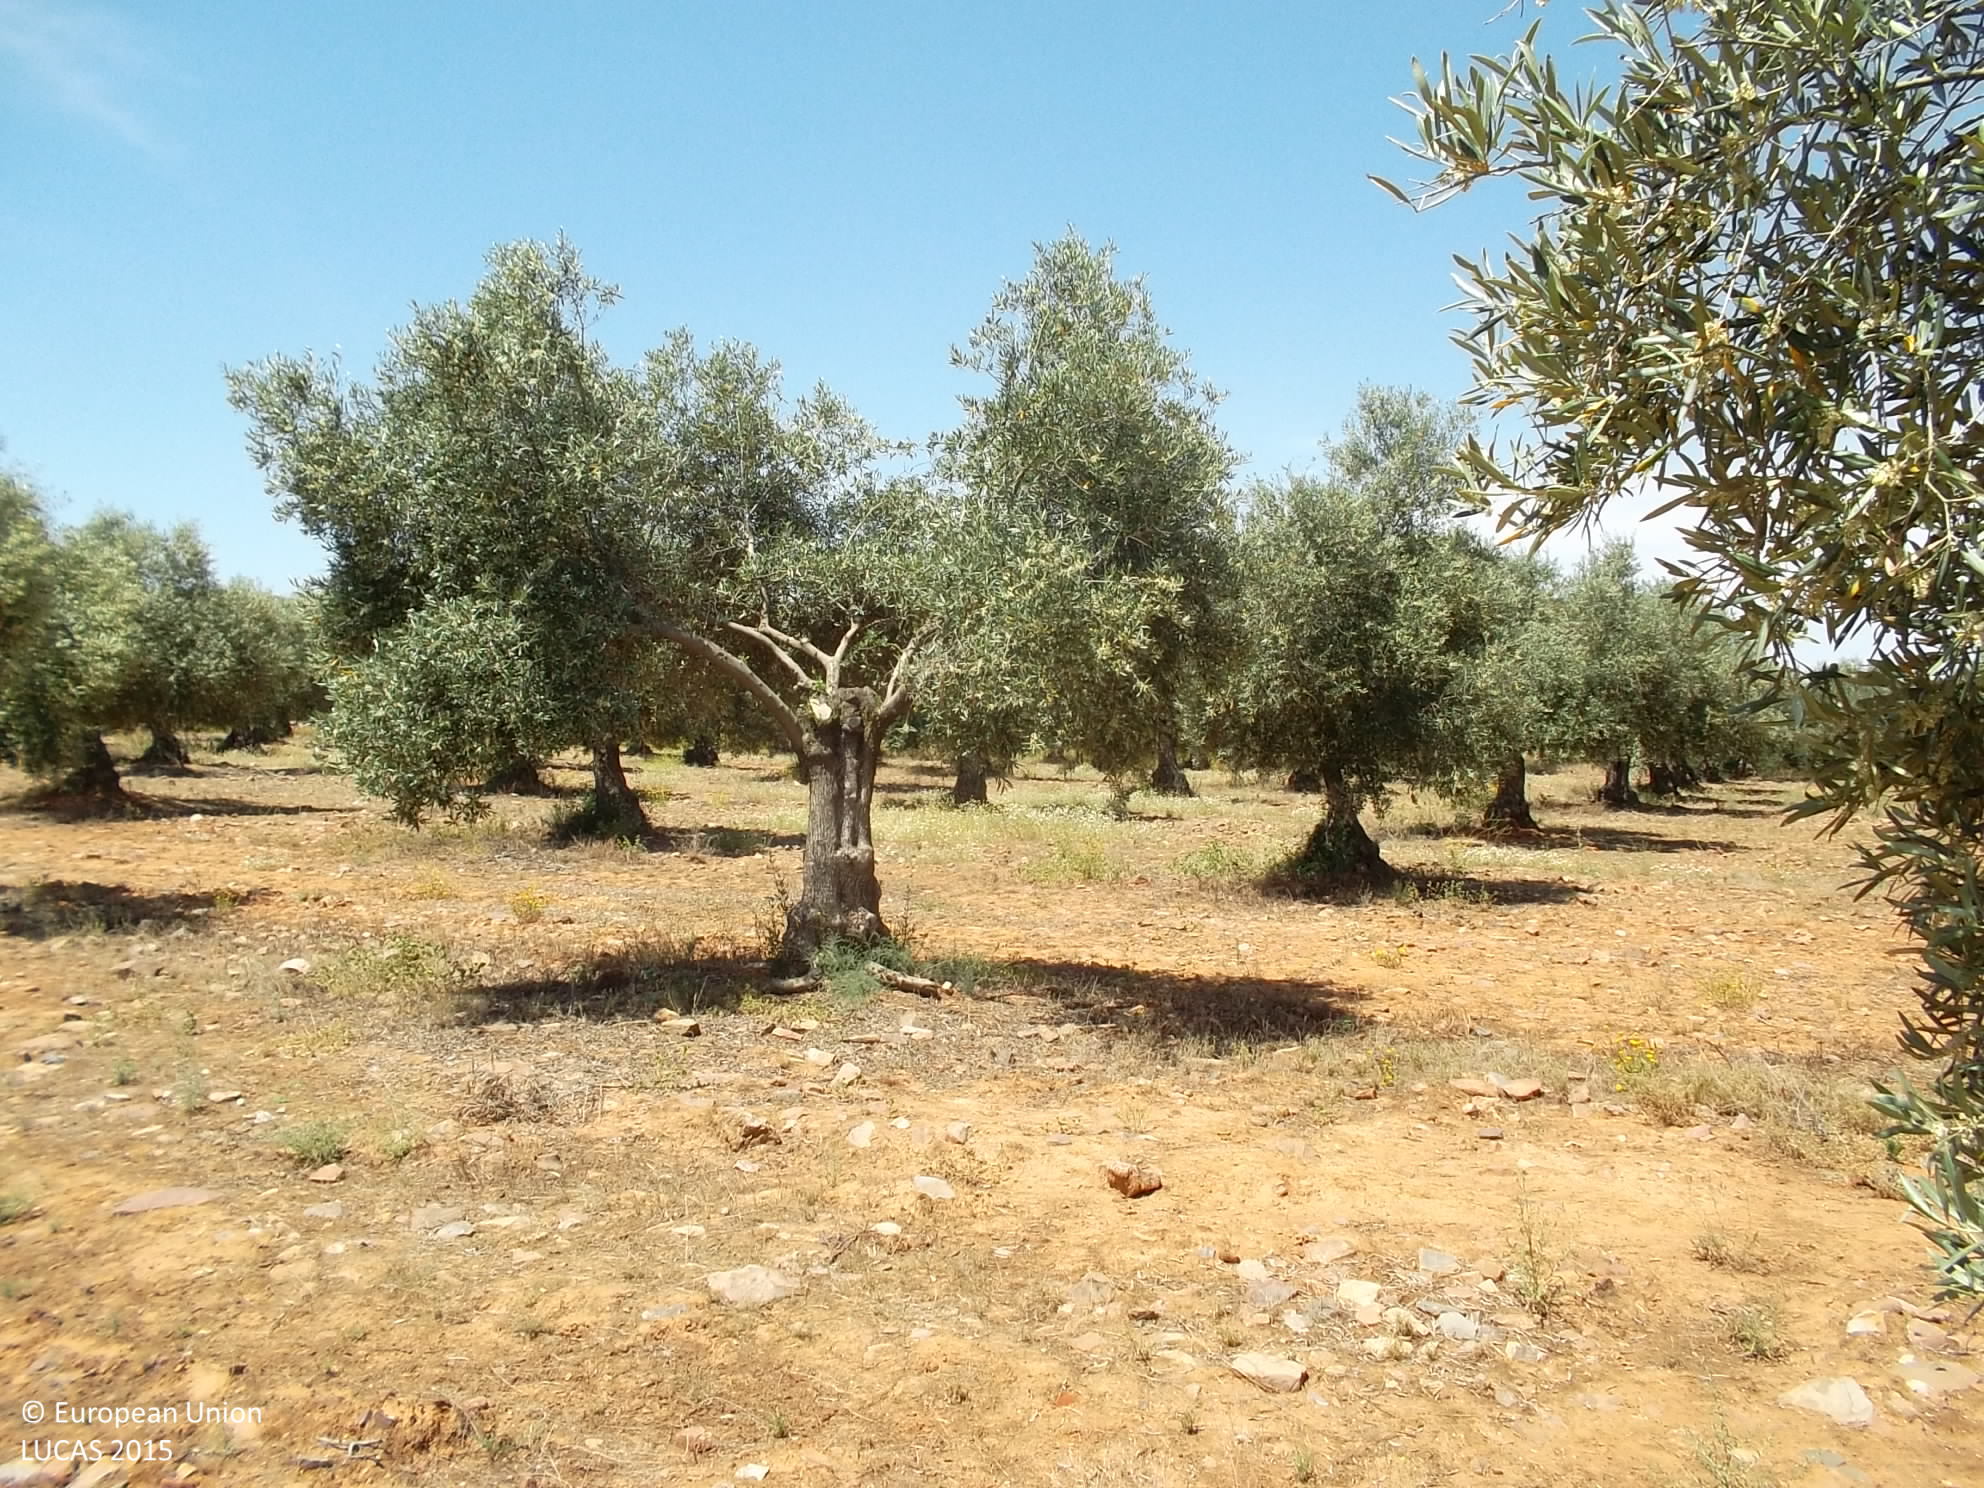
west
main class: Cropland
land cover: Olive groves
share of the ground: 25 - 50 %
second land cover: Spontaneously vegetated surfaces
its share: 25 - 50 %
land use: Agriculture (excluding fallow land and kitchen gardens)
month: May
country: ES
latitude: 38.6612
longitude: -4.7945
